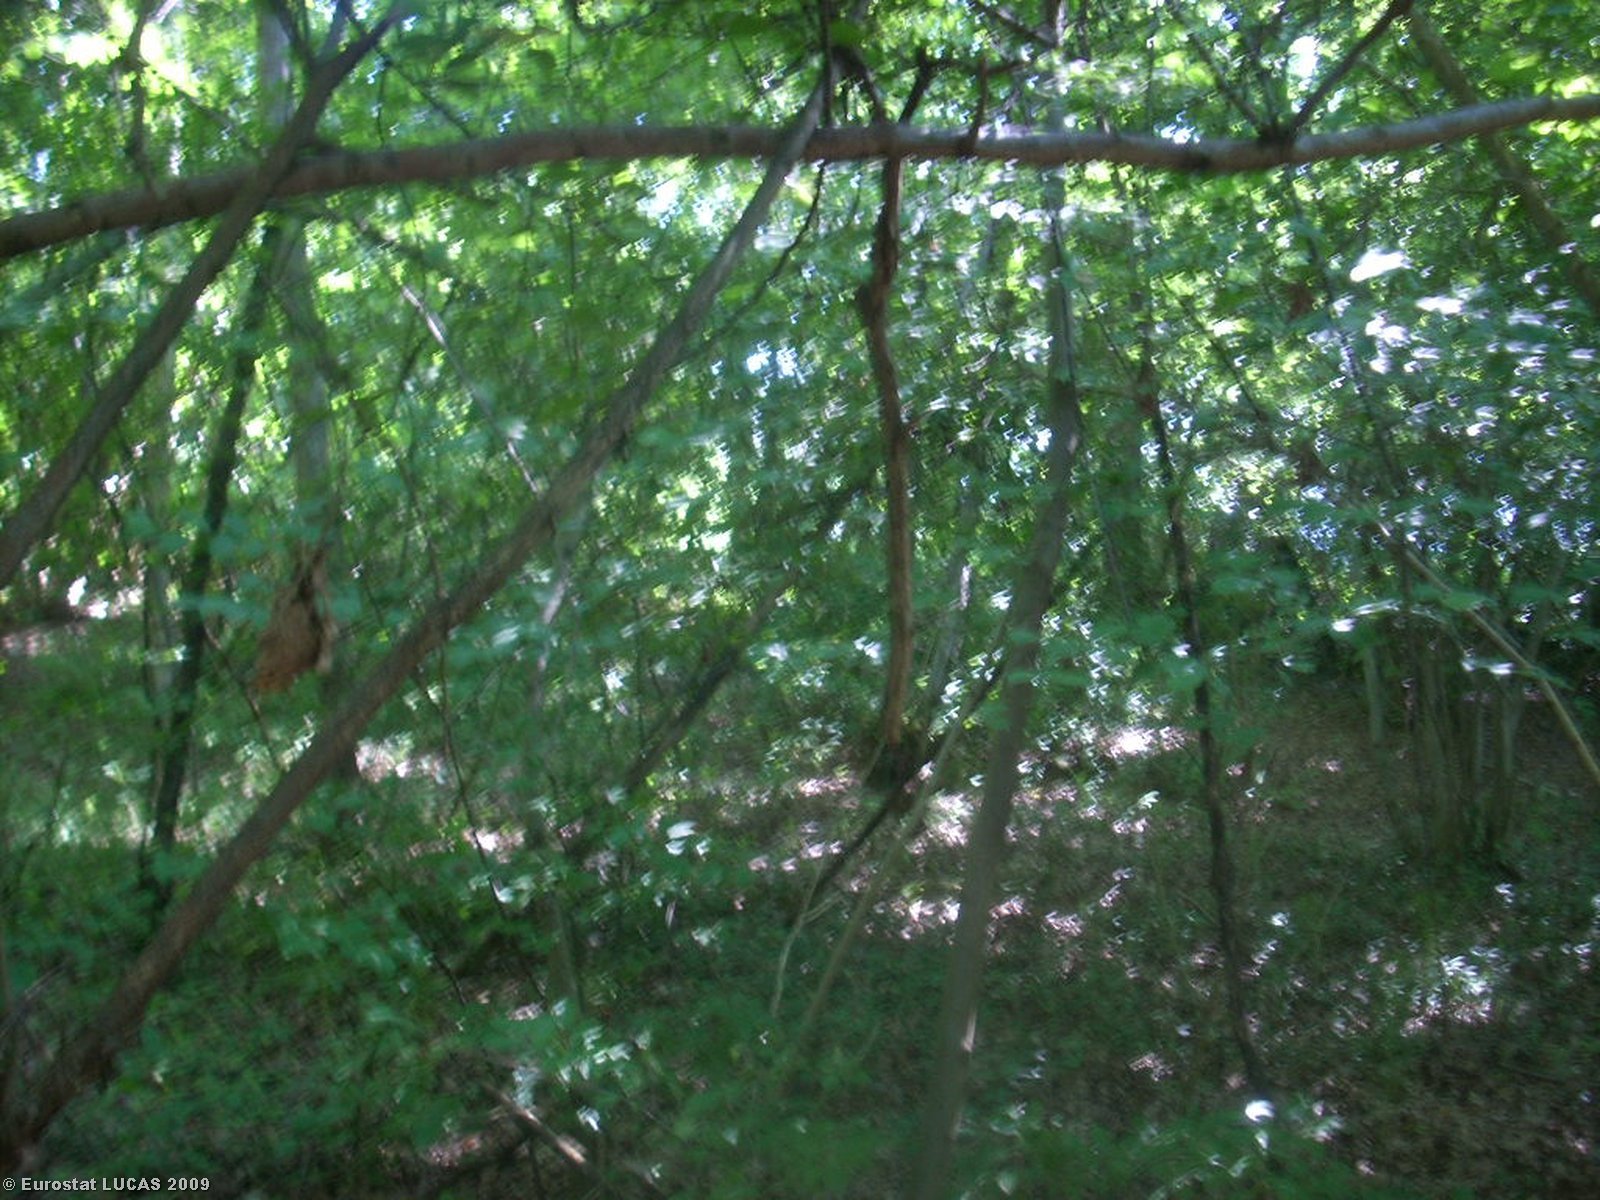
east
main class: Woodland
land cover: Broadleaved woodland
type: acidophilous oak and oak-birch forest
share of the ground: > 75 %
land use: Forestry
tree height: > 5 m
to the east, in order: Broadleaved woodland
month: May
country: IT
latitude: 44.7154
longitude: 7.4171
